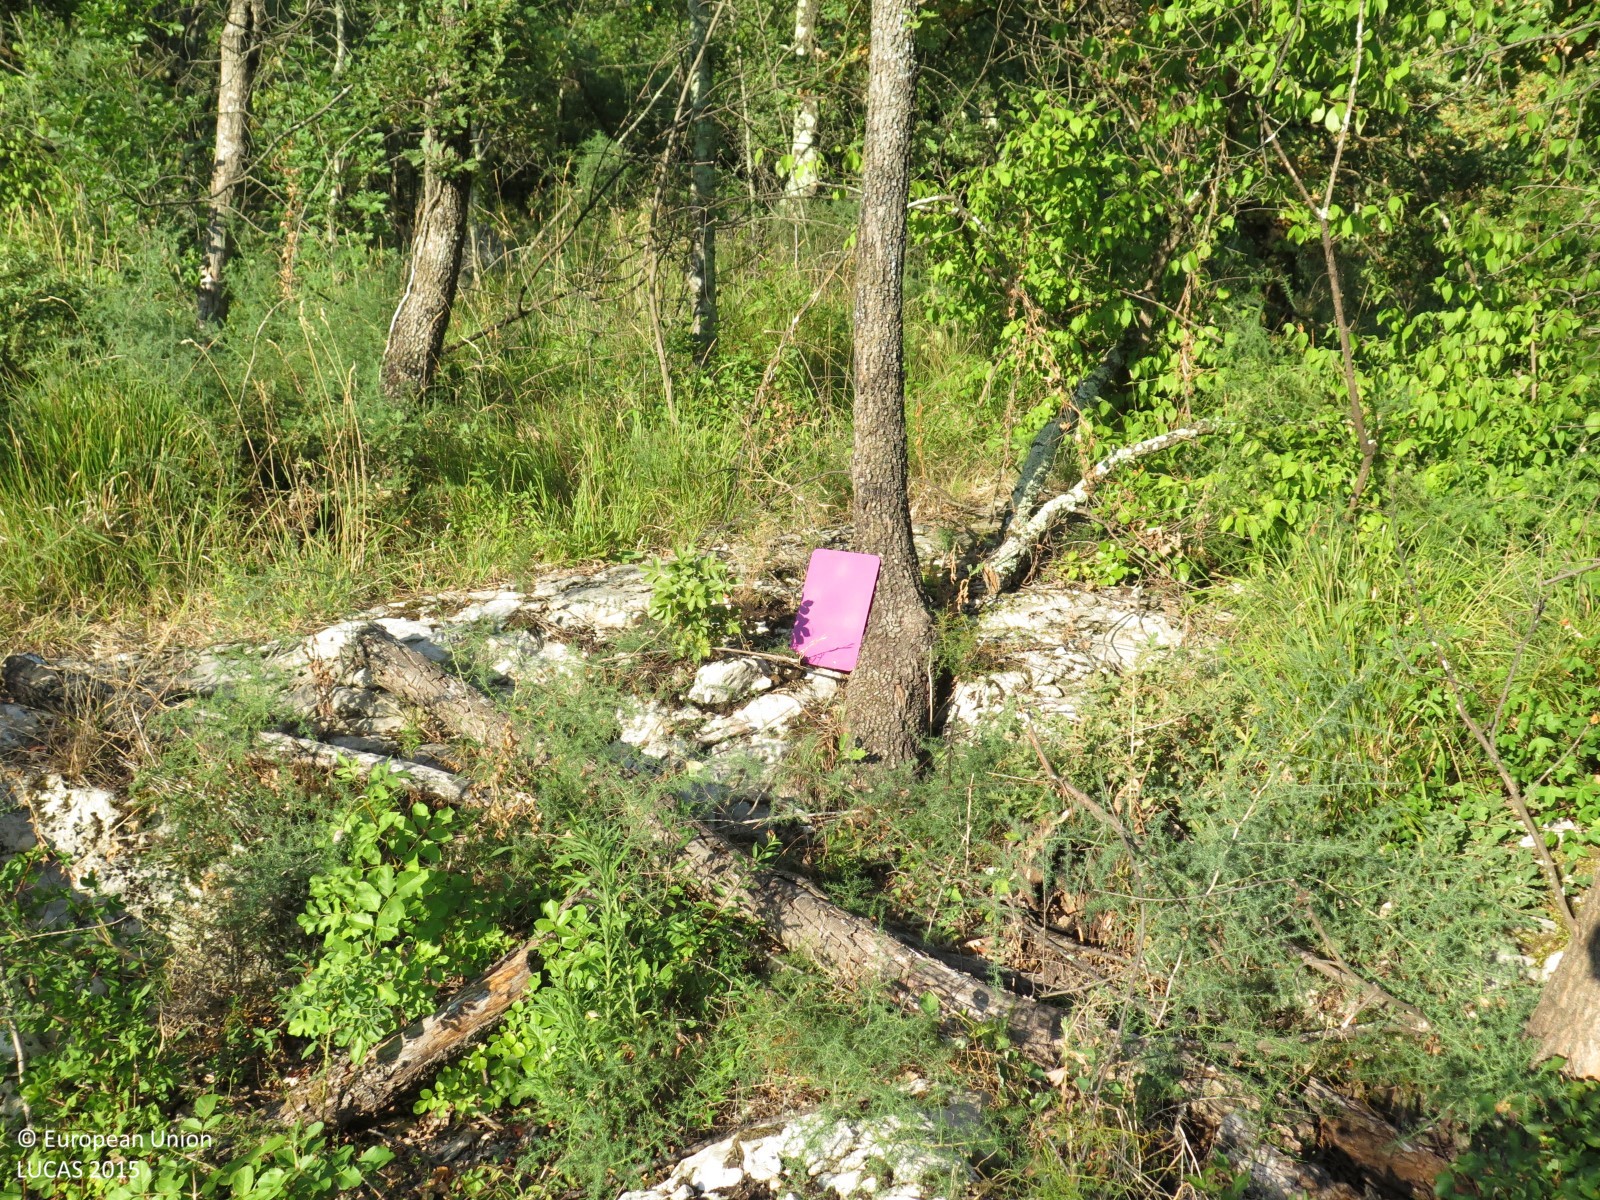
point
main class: Woodland
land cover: Broadleaved woodland
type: acidophilous oak and oak-birch forest
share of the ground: > 75 %
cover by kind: broadleaved forest trees 90 %, herbaceous plants 10 %
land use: Semi-natural and natural areas not in use
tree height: > 5 m
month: July
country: HR
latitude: 45.3539
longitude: 14.0669
